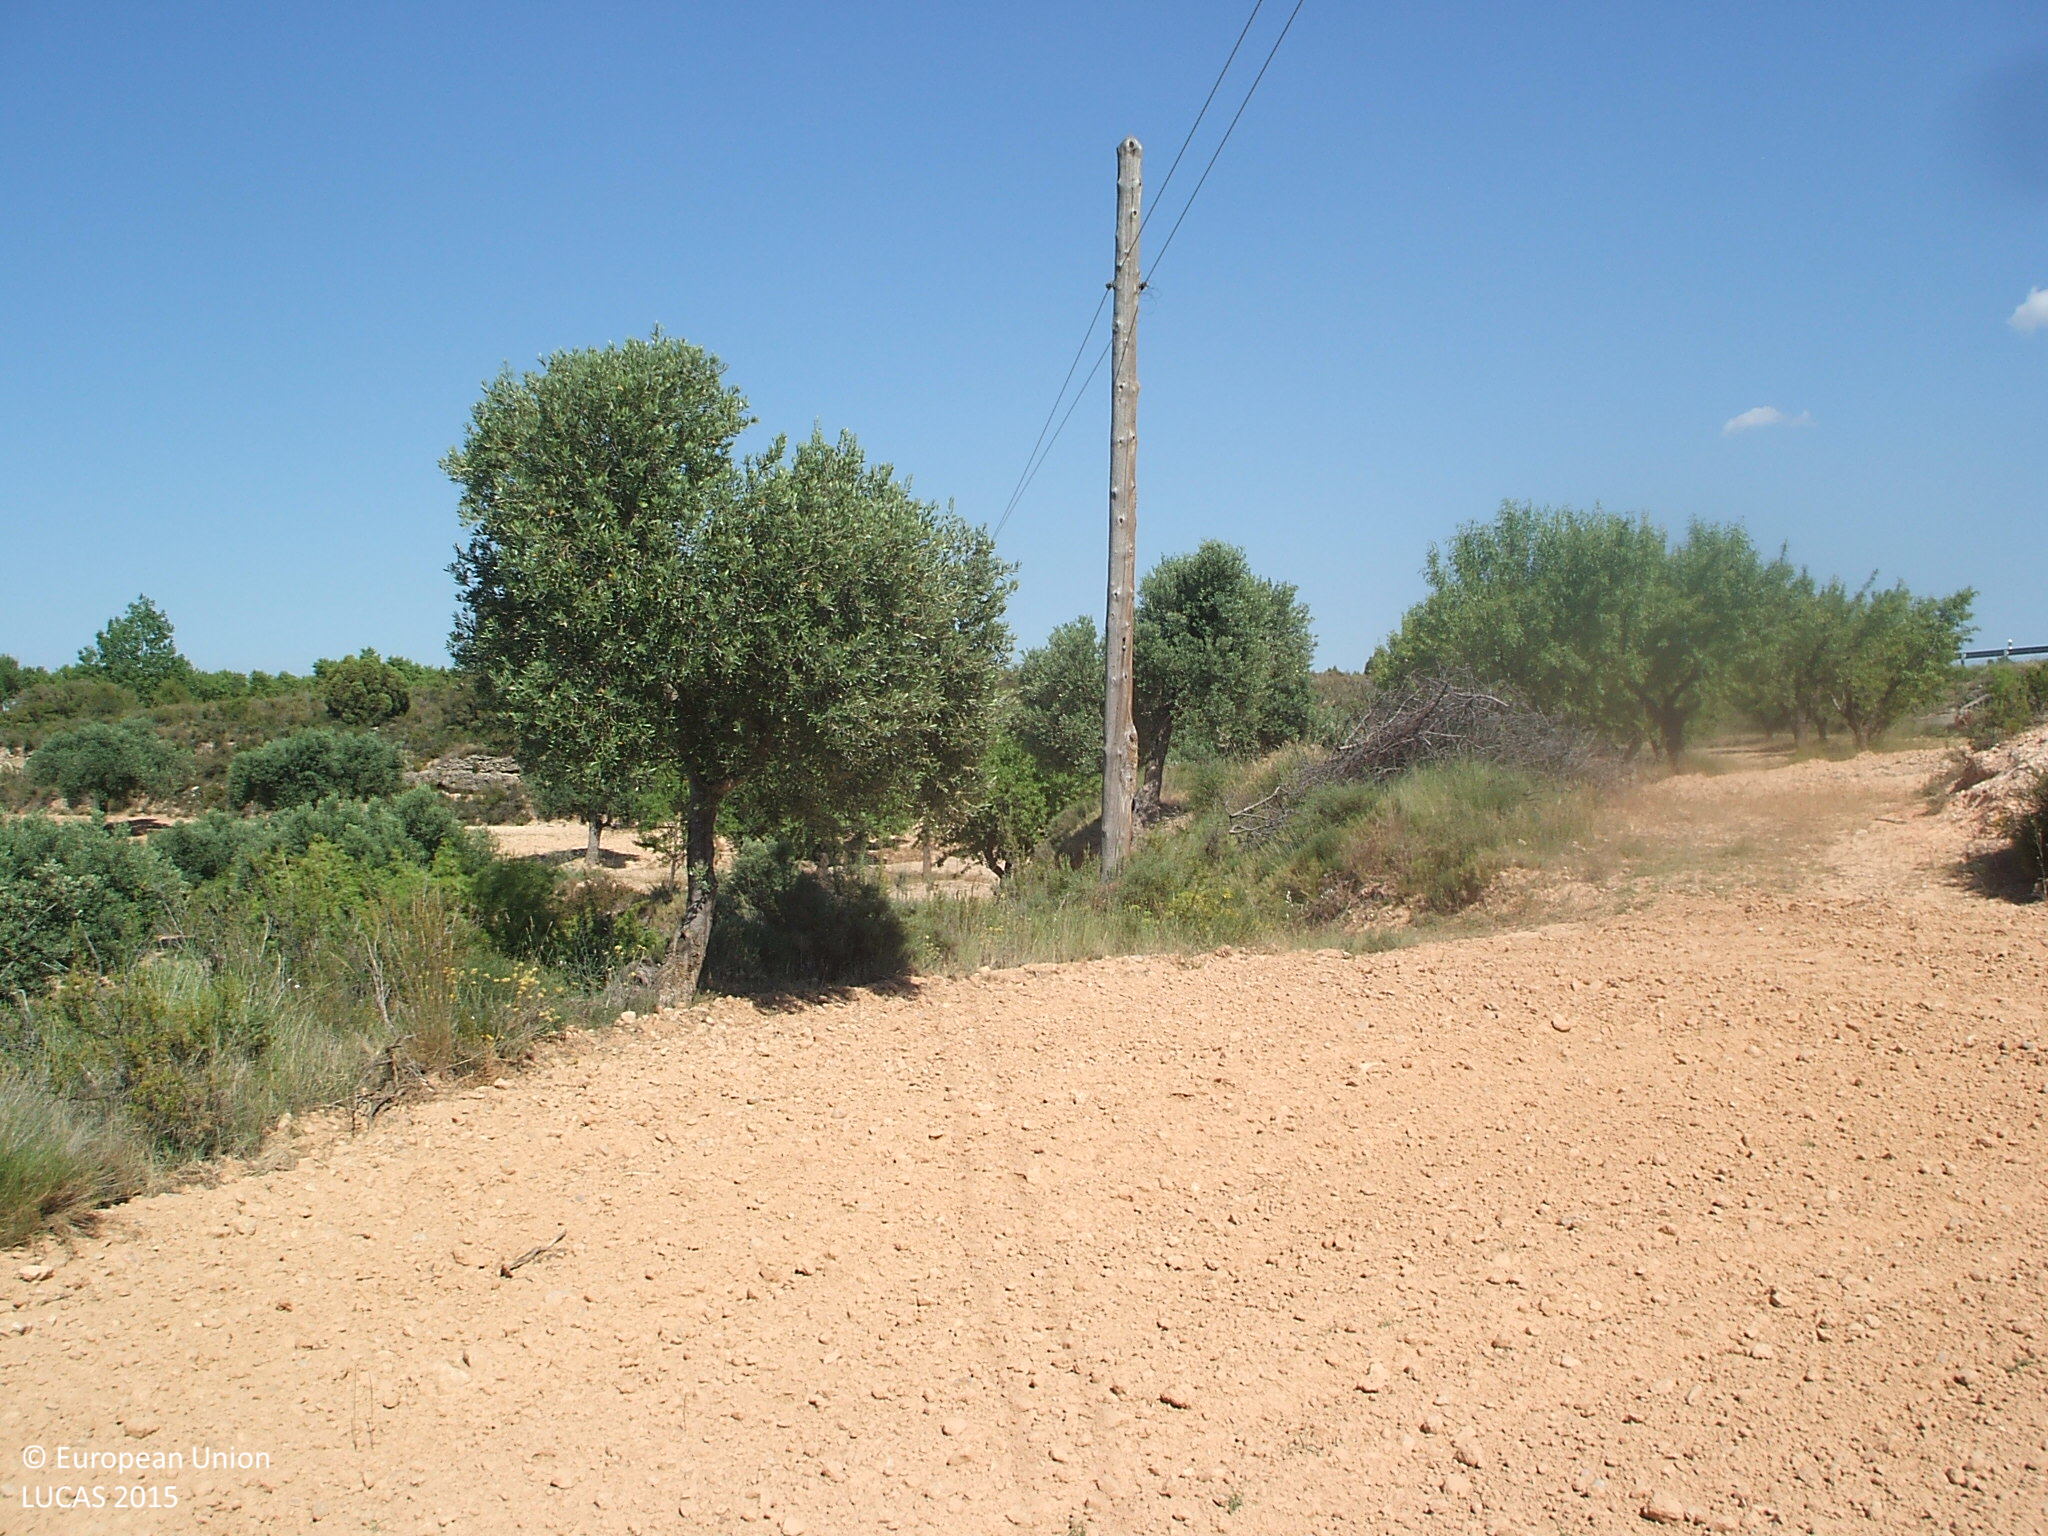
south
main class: Cropland
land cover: Olive groves
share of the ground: 10 - 25 %
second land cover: Other bare soil
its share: > 75 %
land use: Agriculture (excluding fallow land and kitchen gardens)
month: June
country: ES
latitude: 40.9725
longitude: -0.0280
